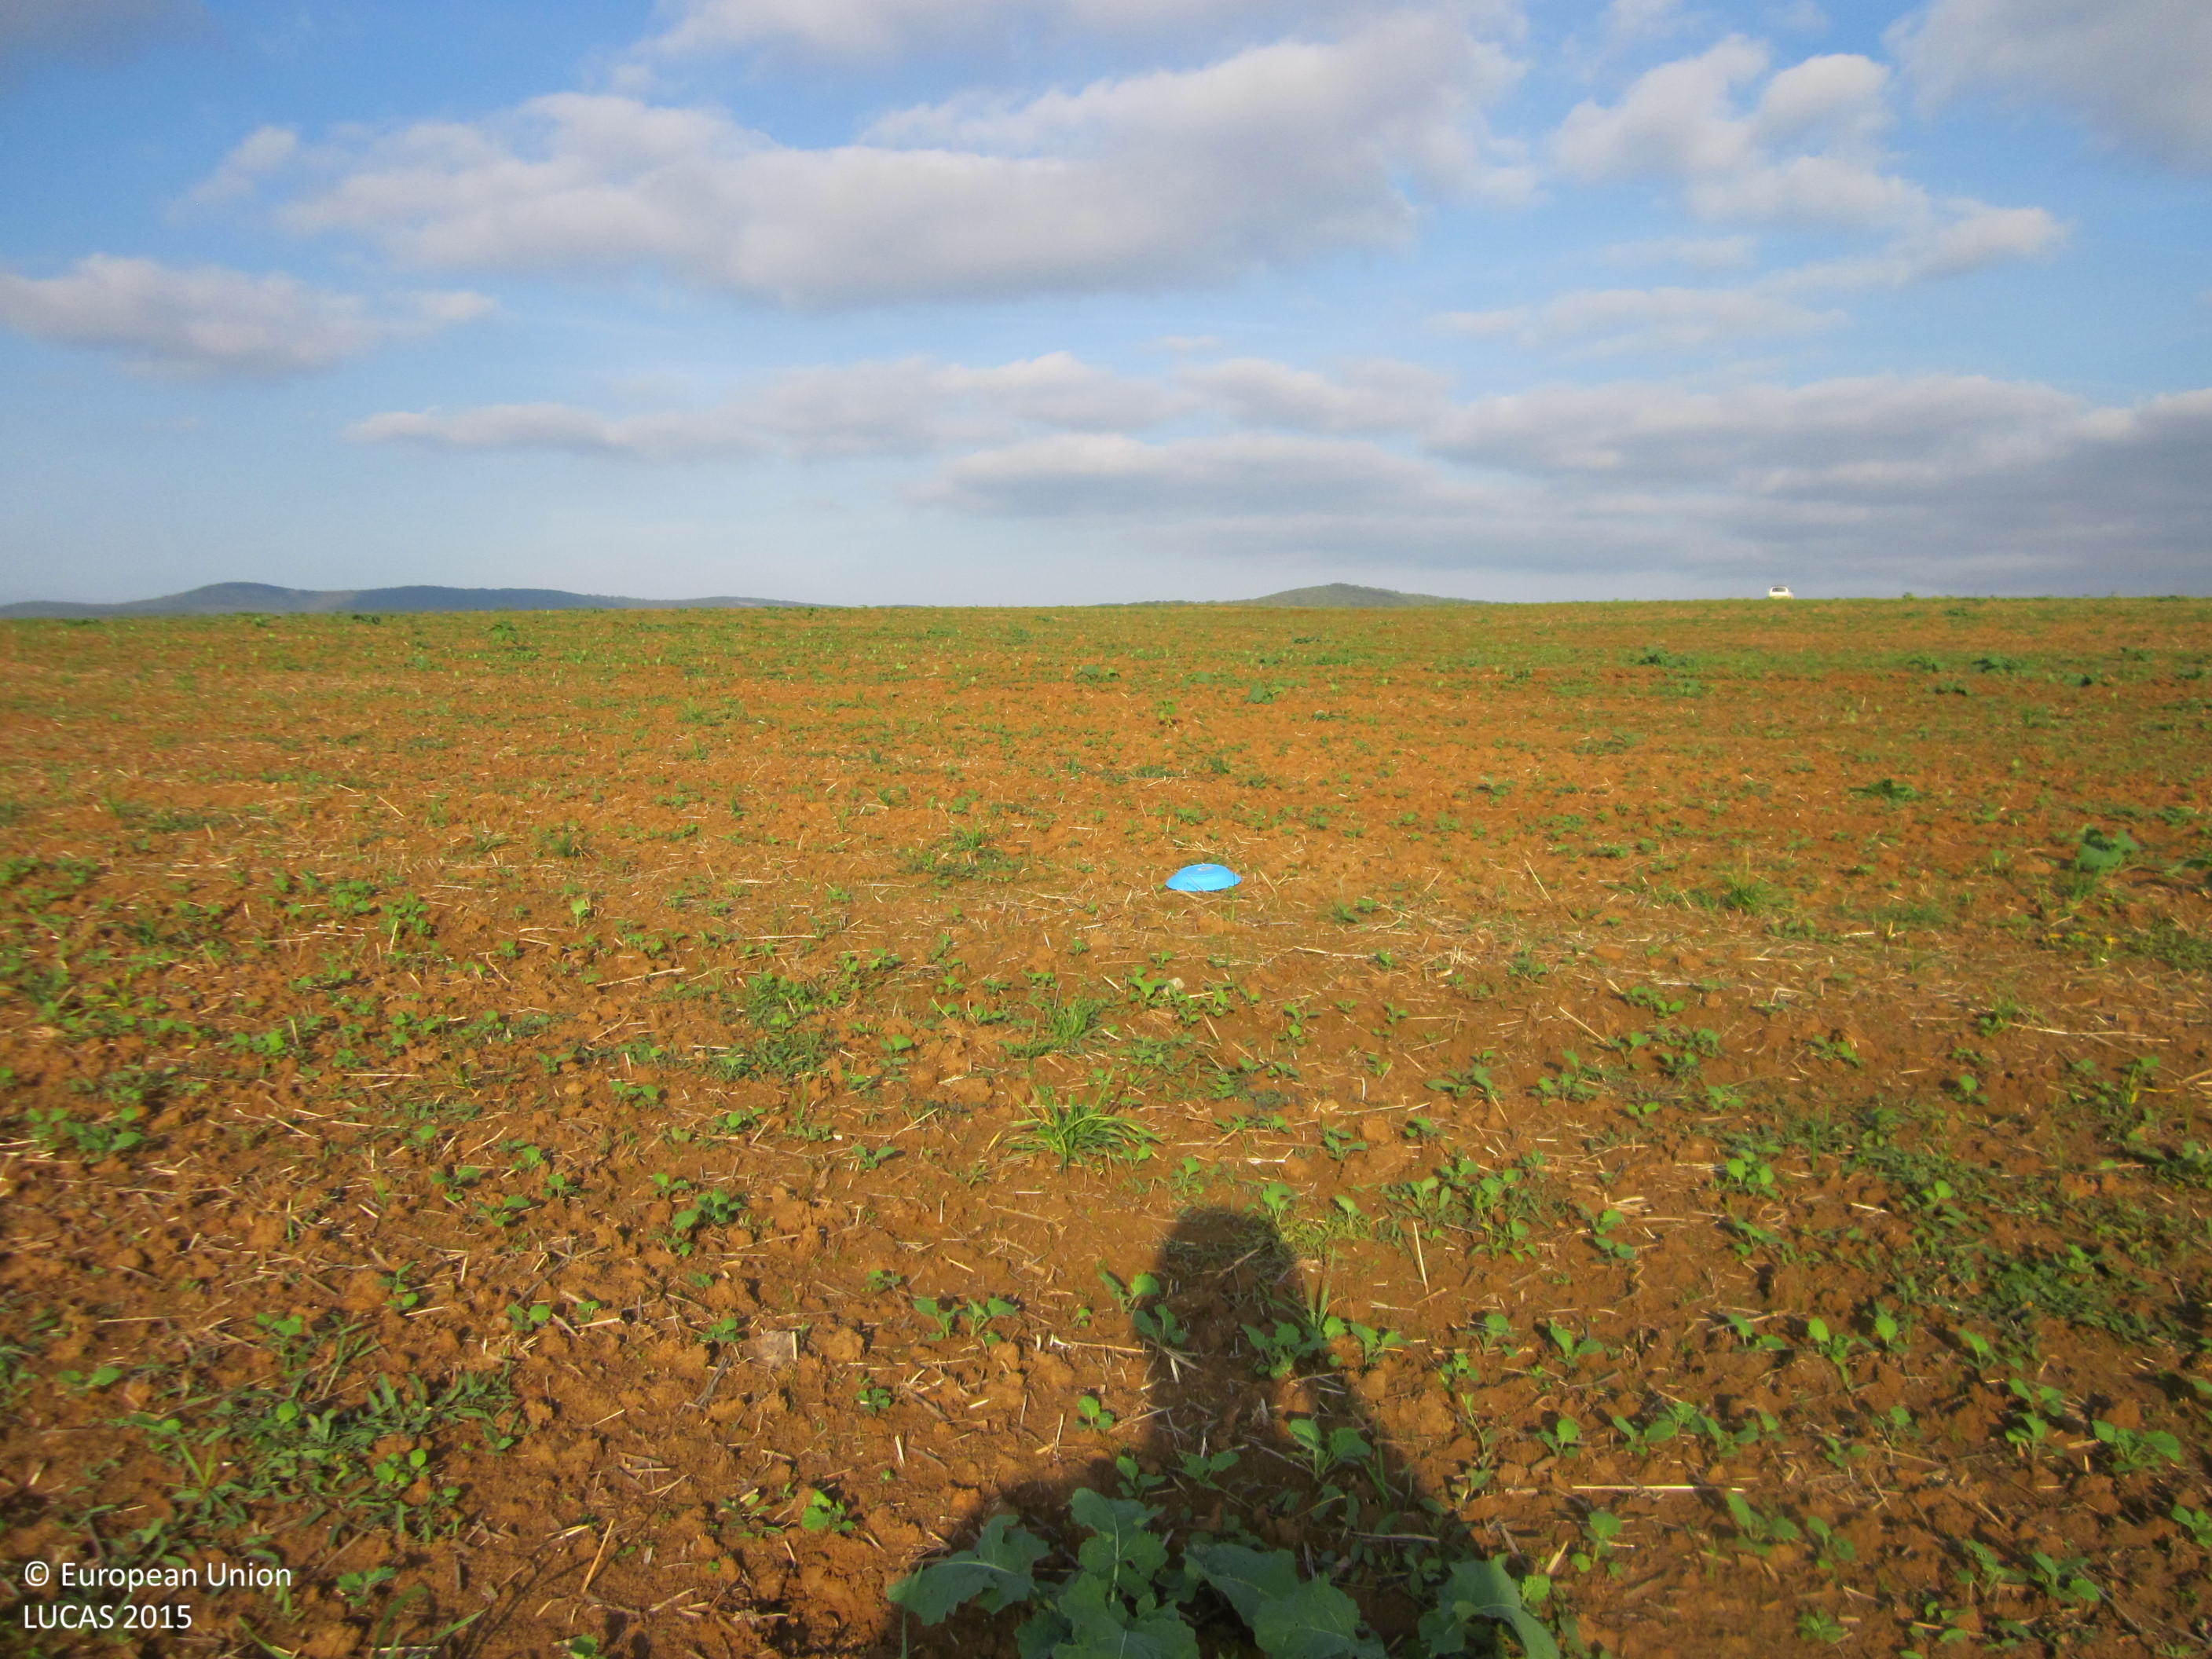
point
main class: Cropland
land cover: Rape and turnip rape
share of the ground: 10 - 25 %
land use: Agriculture (excluding fallow land and kitchen gardens)
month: October
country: BG
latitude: 42.7530
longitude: 26.8801
